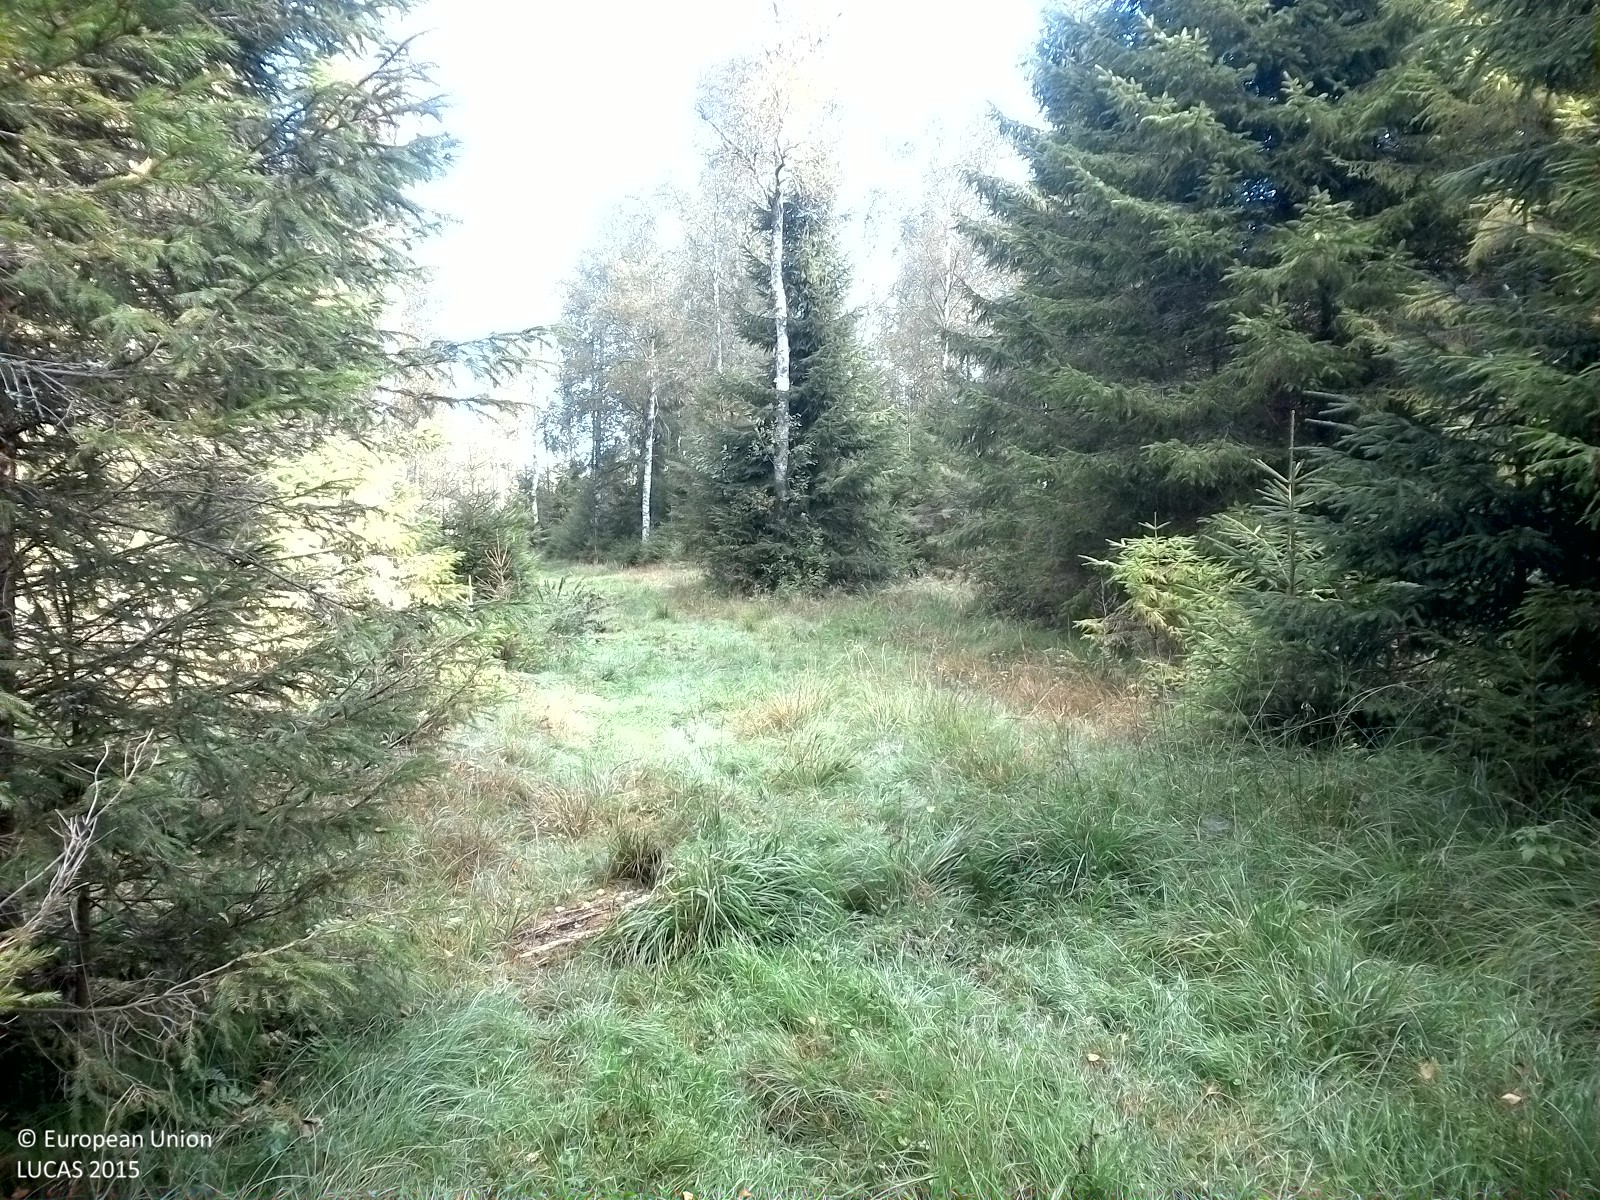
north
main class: Grassland
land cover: Grassland without tree/shrub cover
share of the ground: > 75 %
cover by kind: herbaceous plants 95 %, unconsolidated bare surface 5 %
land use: Amenities, museums, leisure
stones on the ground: < 10 %
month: August
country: SE
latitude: 59.0966
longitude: 15.5610
